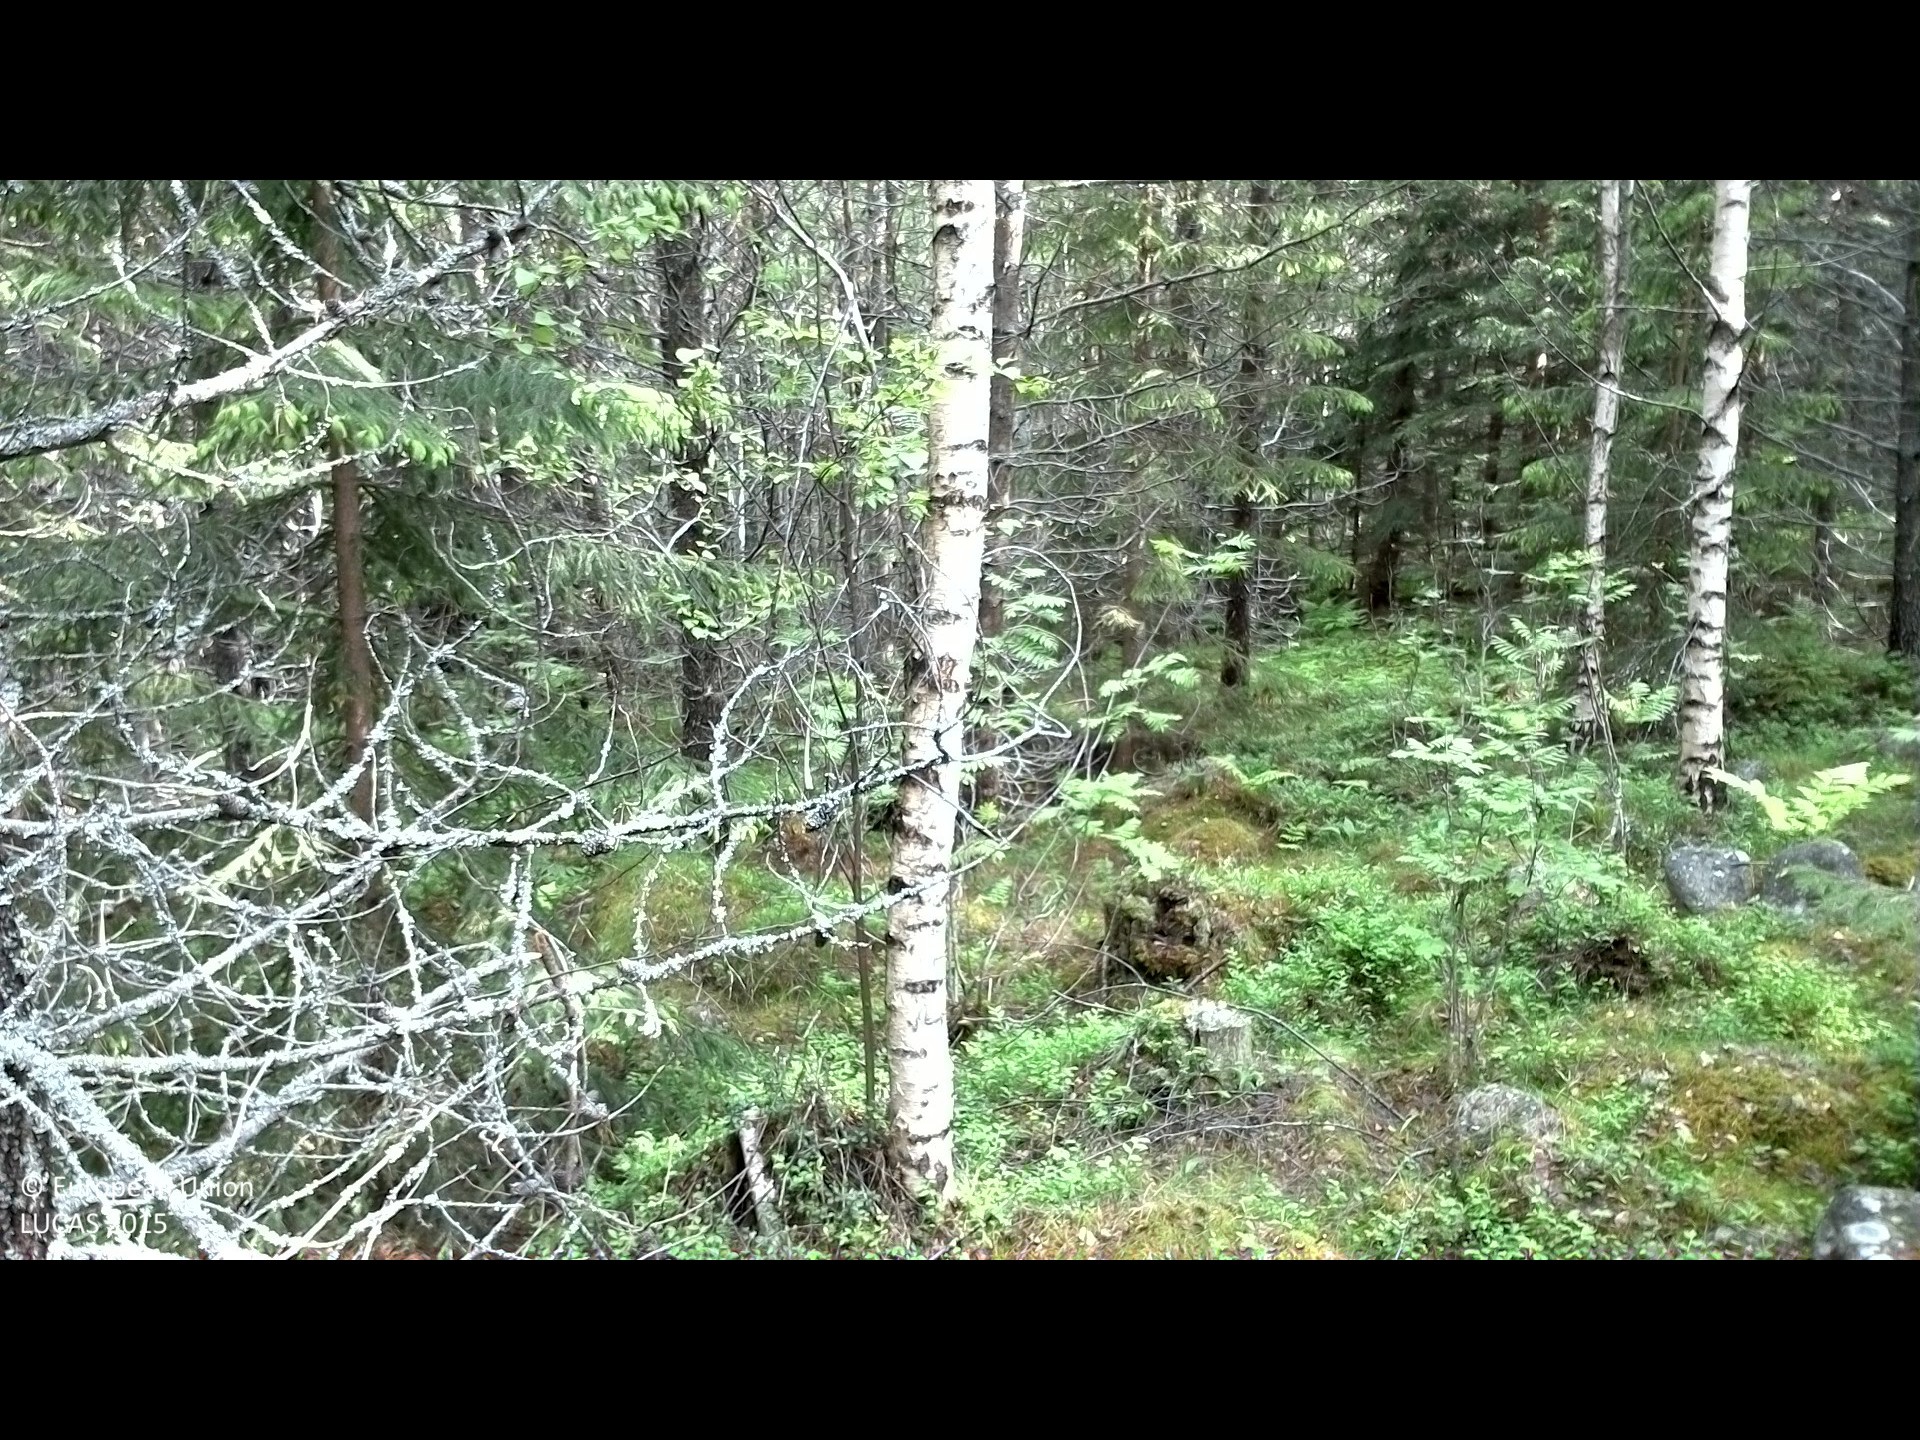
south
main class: Woodland
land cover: Pine dominated coniferous woodland
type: exotic forest
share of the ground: 50 - 75 %
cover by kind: coniferous forest trees 60 %, shrubs 15 %, herbaceous plants 15 %, broadleaved forest trees 5 %, lichens and mosses 5 %
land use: Forestry
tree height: > 5 m
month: June
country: SE
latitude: 62.0438
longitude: 16.7697
